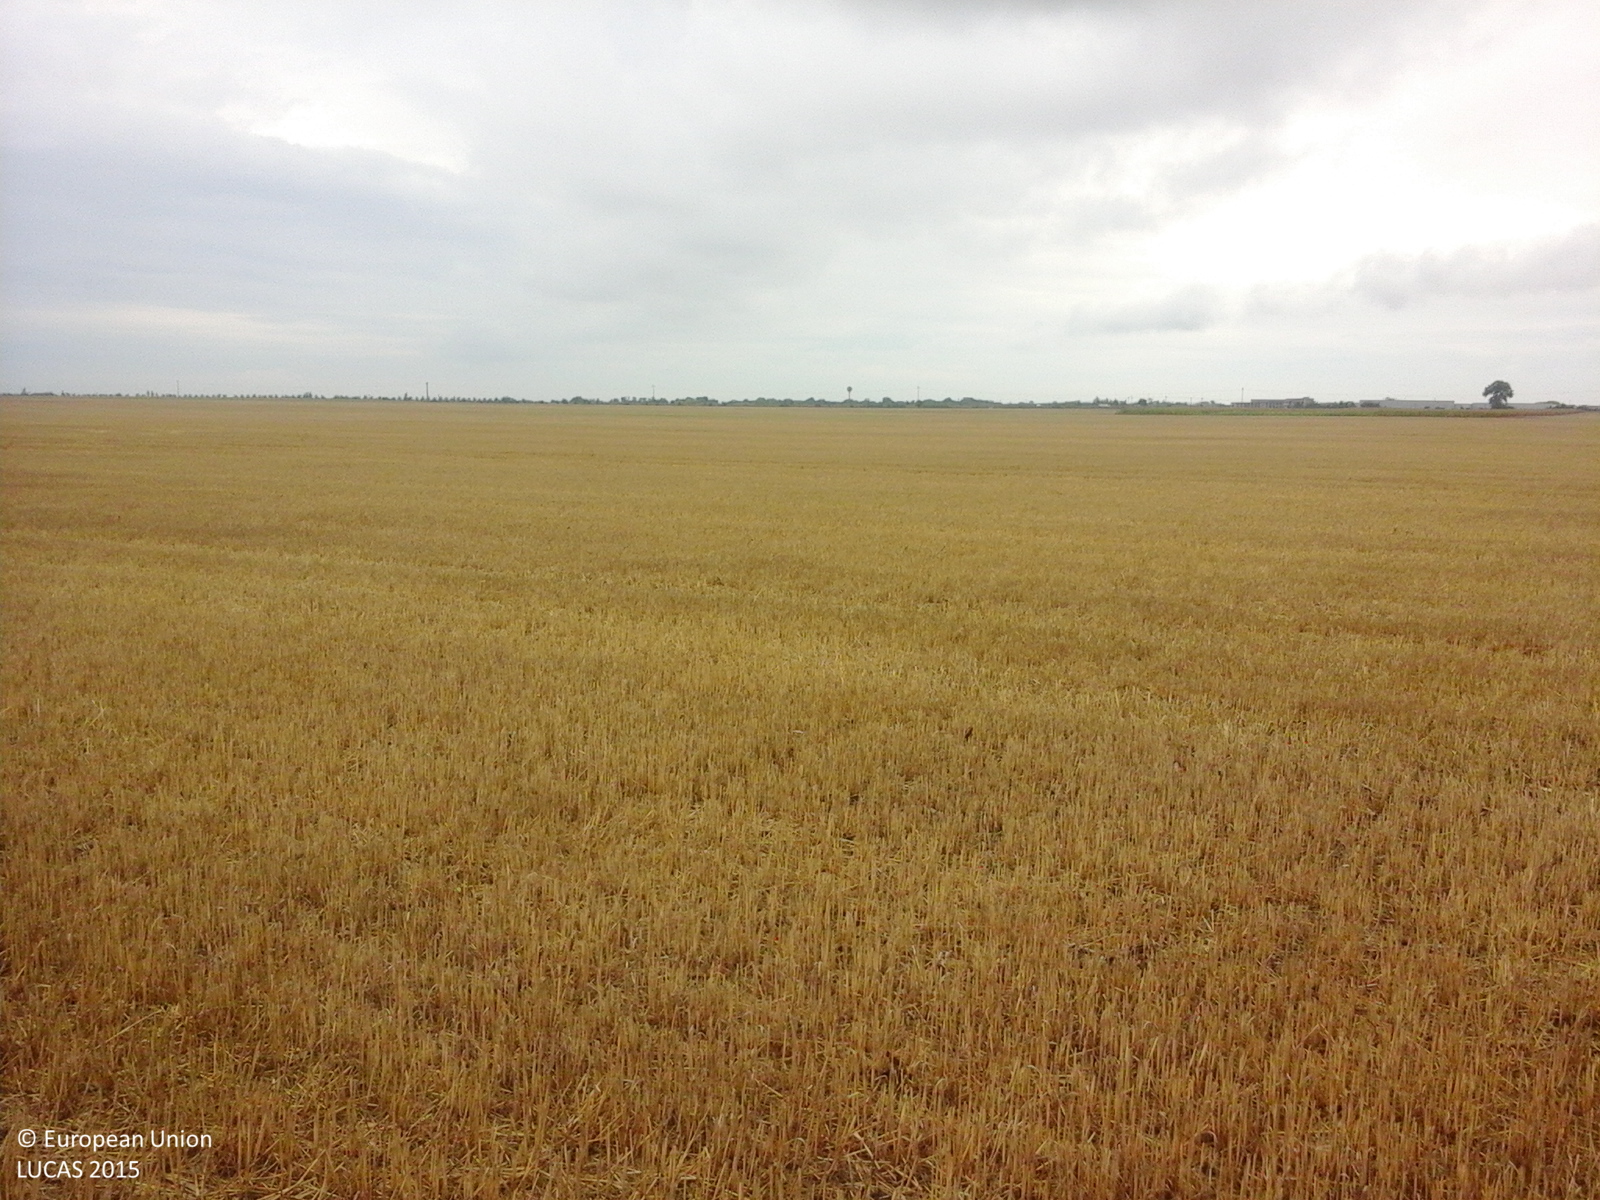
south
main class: Cropland
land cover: Common wheat
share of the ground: > 75 %
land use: Agriculture (excluding fallow land and kitchen gardens)
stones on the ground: < 10 %
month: August
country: RO
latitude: 45.8084
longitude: 20.7447
